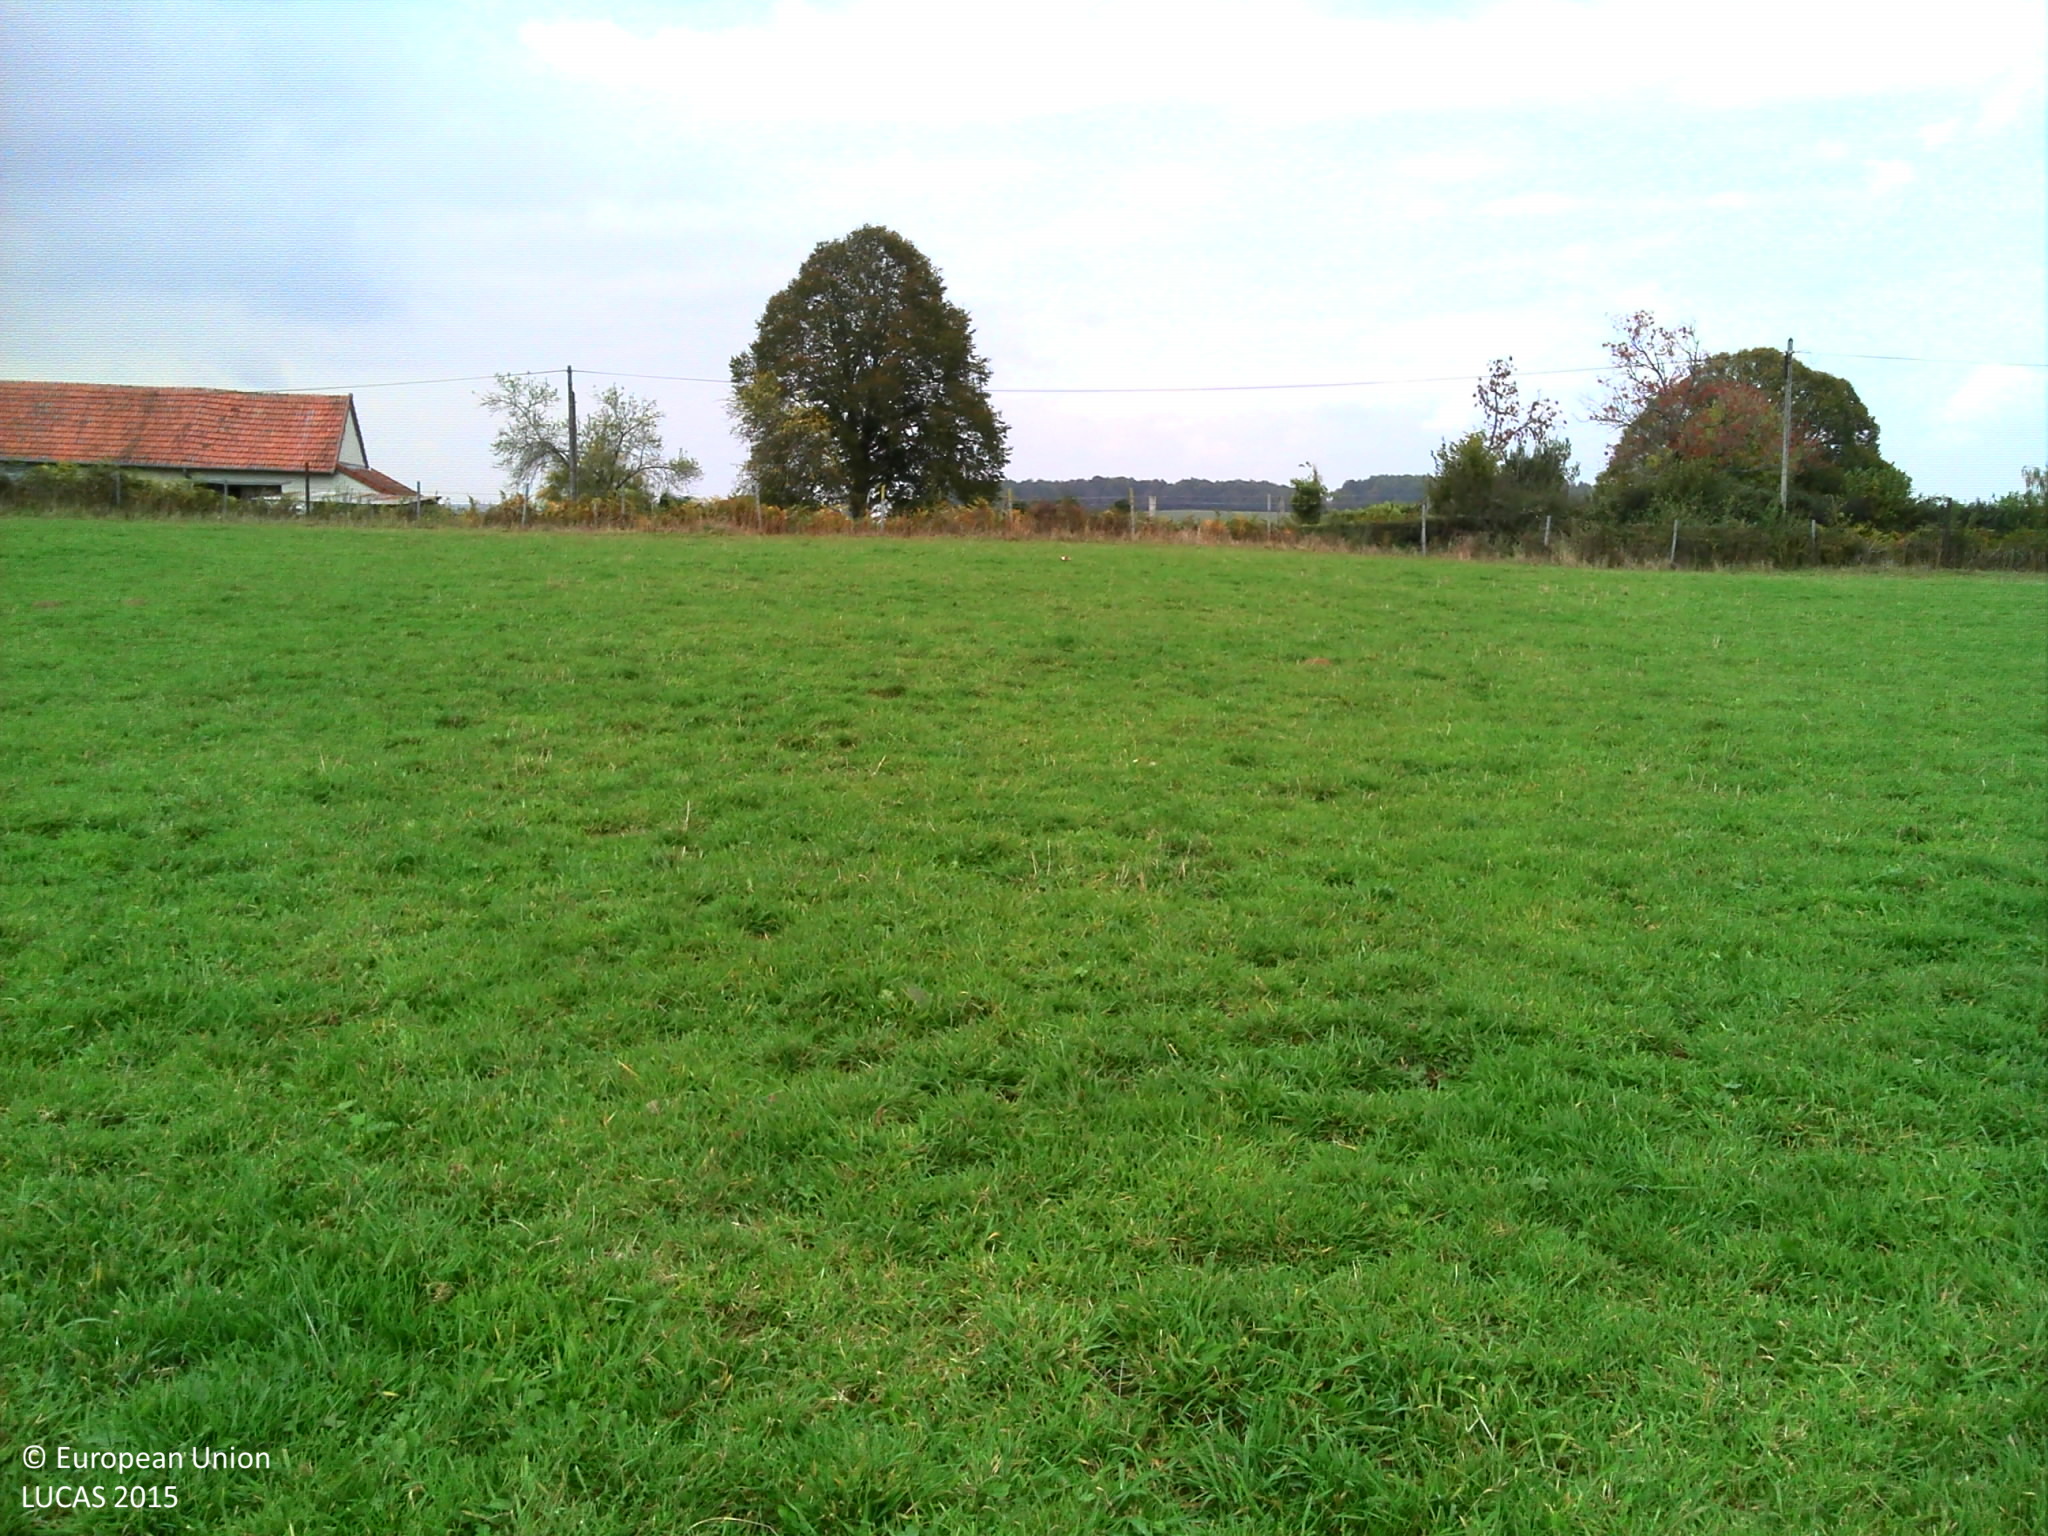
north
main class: Grassland
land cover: Grassland without tree/shrub cover
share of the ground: > 75 %
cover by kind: herbaceous plants 100 %
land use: Agriculture (excluding fallow land and kitchen gardens)
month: October
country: FR
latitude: 46.1598
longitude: 2.7583
